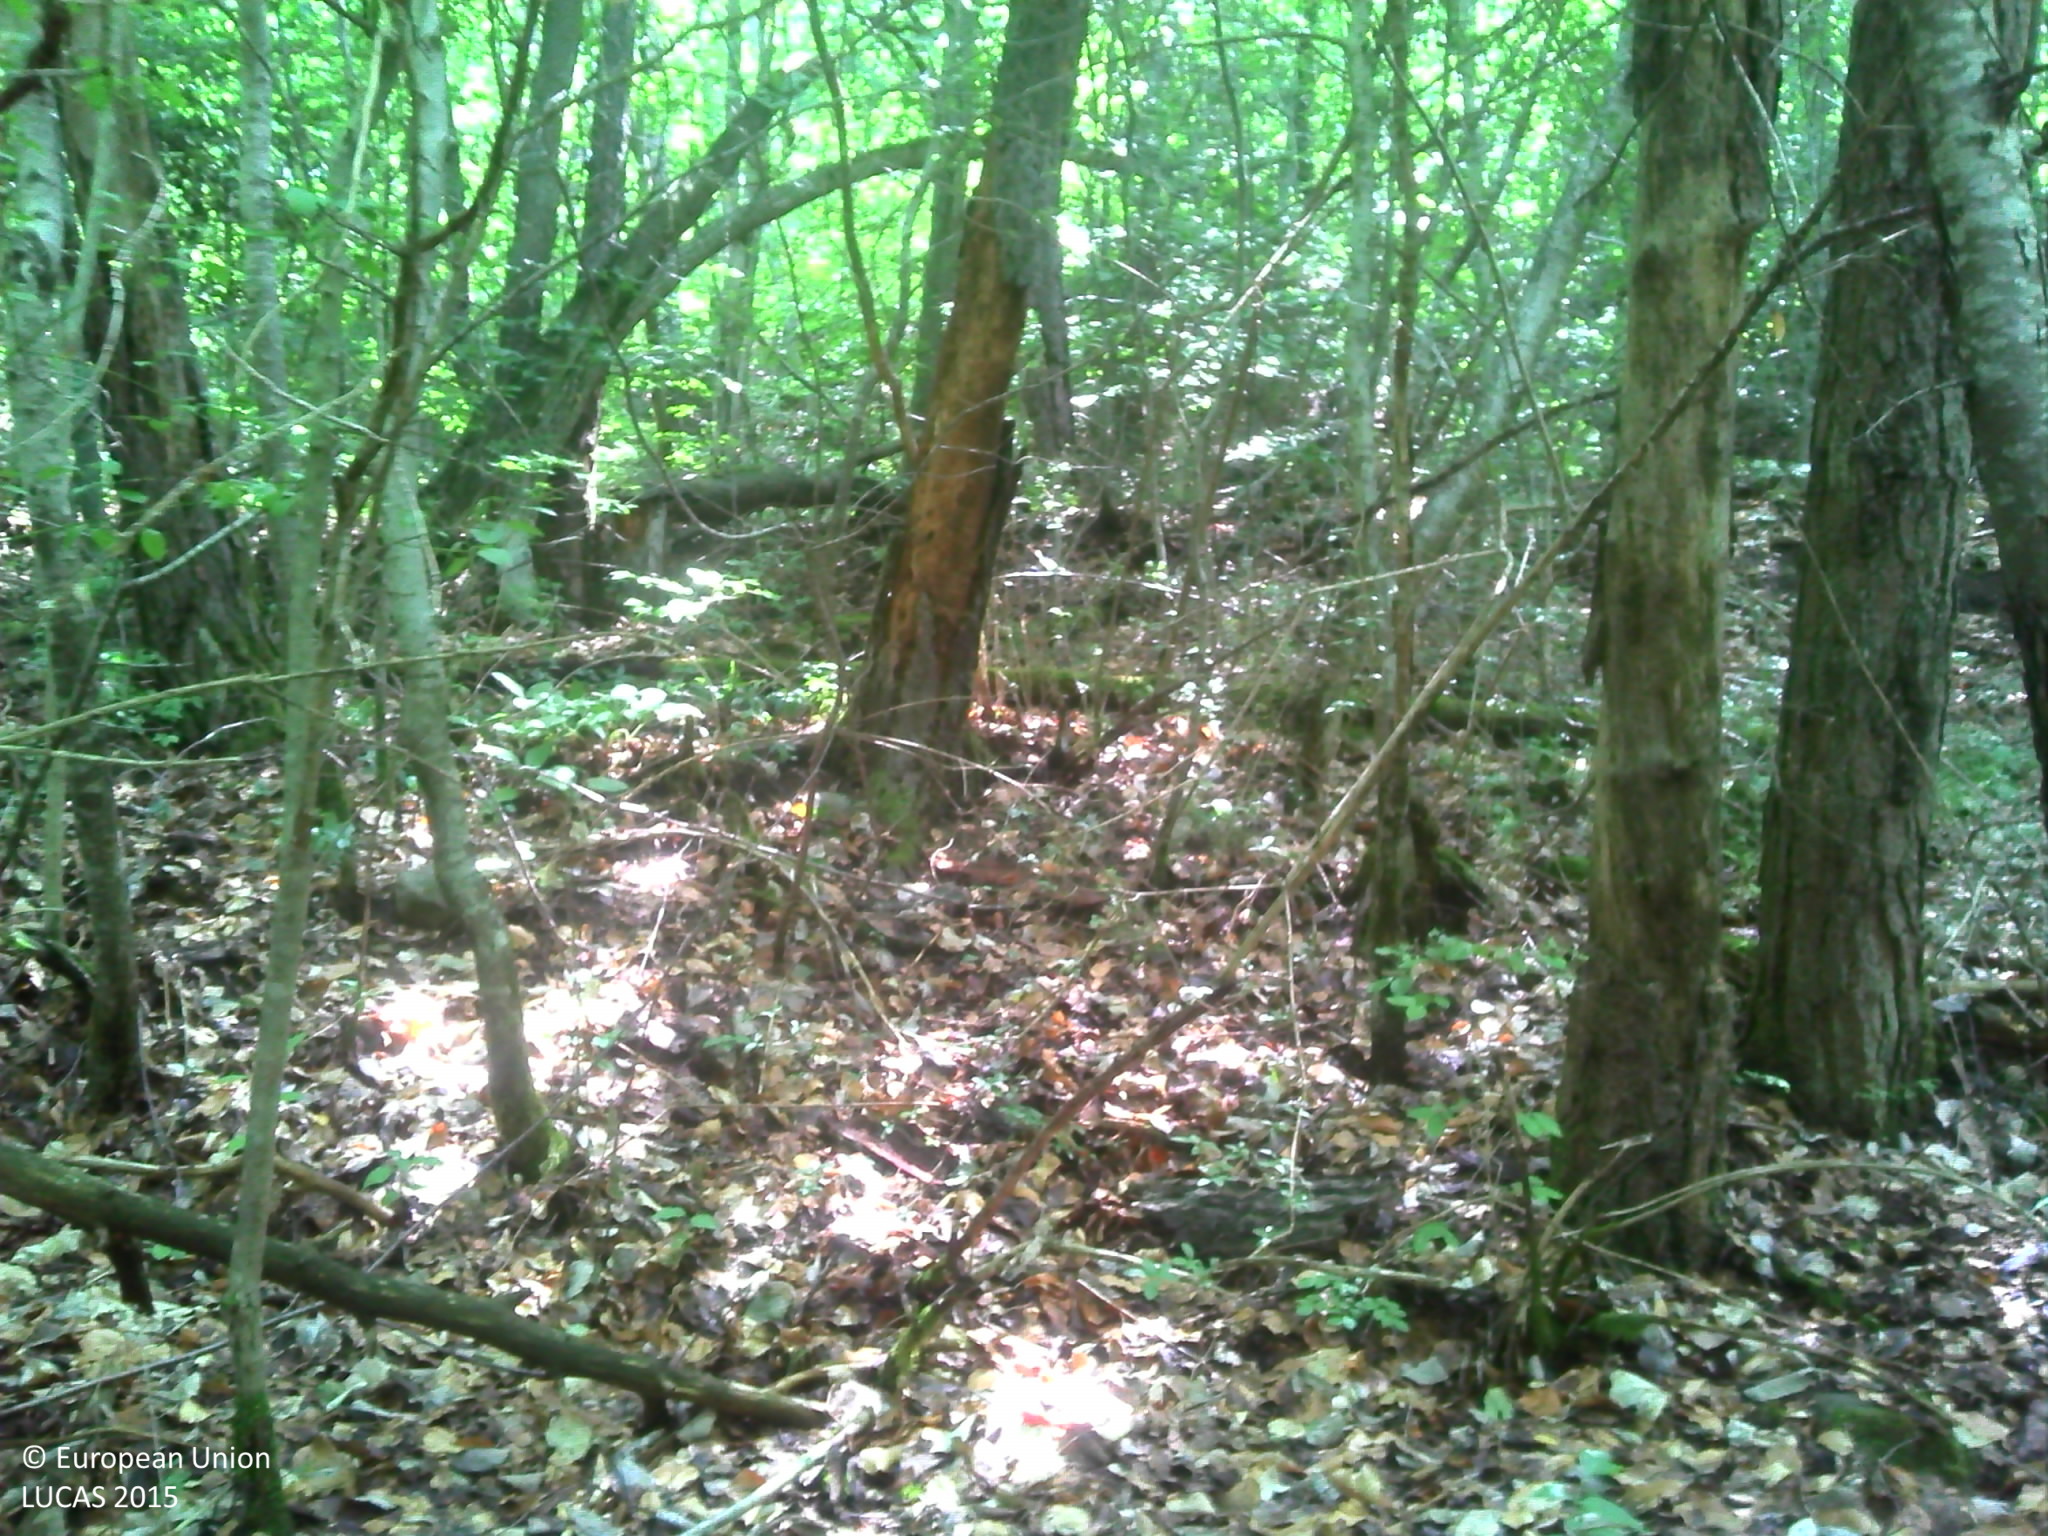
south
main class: Woodland
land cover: Spruce dominated mixed woodland
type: coniferous forest of the mediterranean region
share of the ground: > 75 %
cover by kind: coniferous forest trees 50 %, broadleaved forest trees 35 %, shrubs 10 %, herbaceous plants 5 %
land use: Forestry
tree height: > 5 m
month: July
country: FR
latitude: 44.5029
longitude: 6.3465
